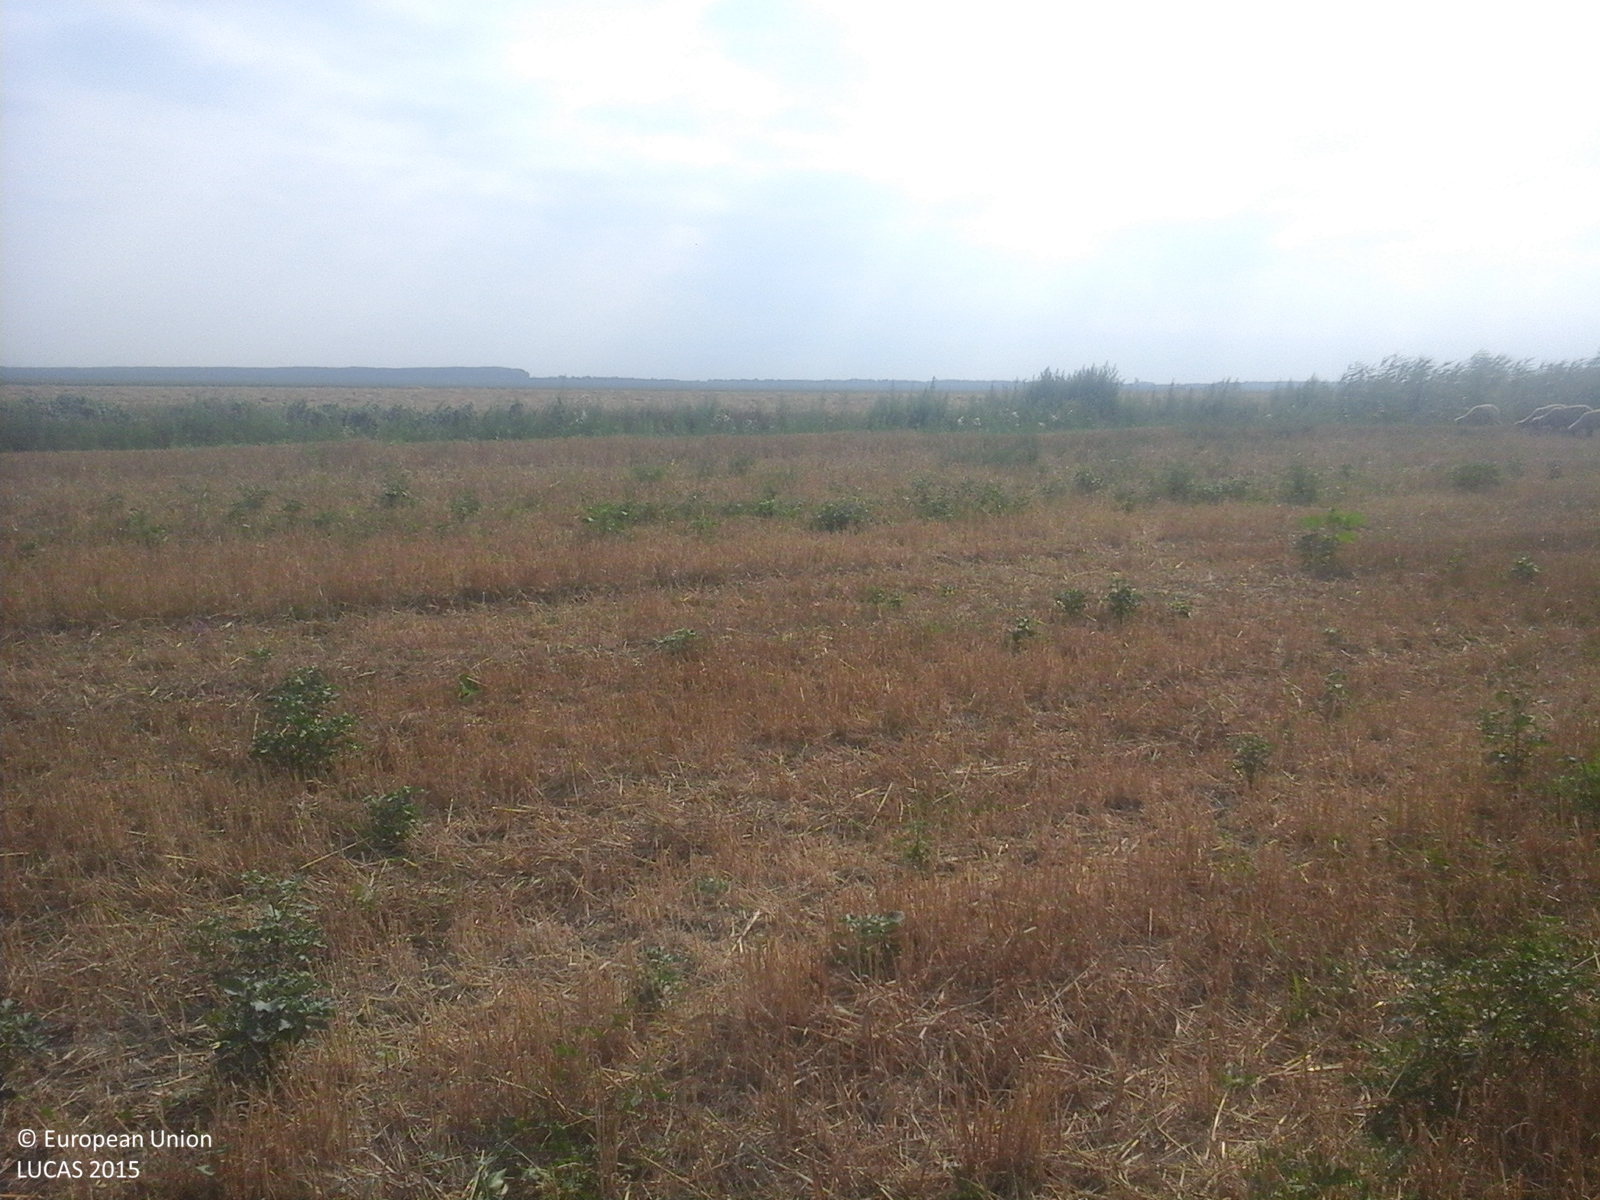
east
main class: Cropland
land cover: Durum wheat
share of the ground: > 75 %
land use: Agriculture (excluding fallow land and kitchen gardens)
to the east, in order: Durum wheat; Inland marshes; Ditches and canals; Durum wheat
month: July
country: RO
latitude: 45.3911
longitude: 28.2496
